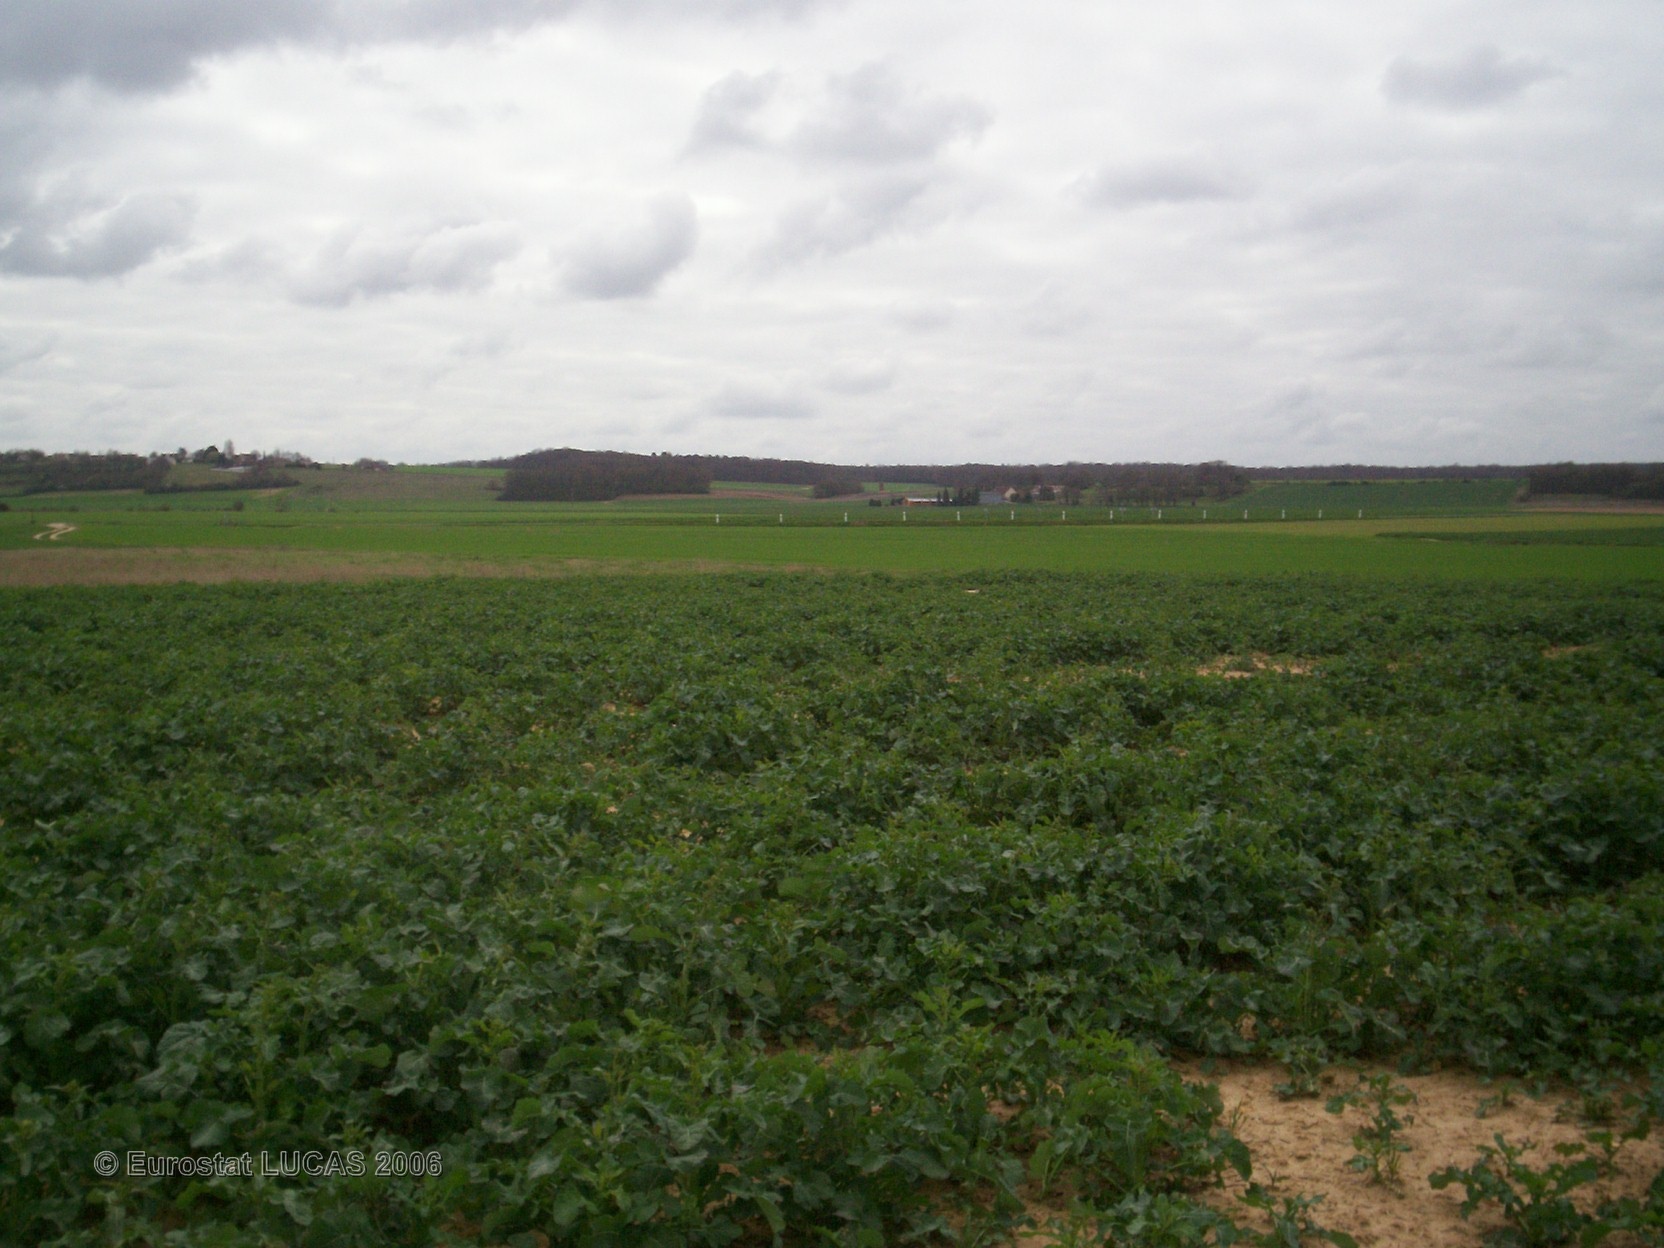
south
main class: Cropland
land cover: Rape and turnip rape
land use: Agriculture (excluding fallow land and kitchen gardens)
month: April
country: FR
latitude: 47.8689
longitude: 1.1725
